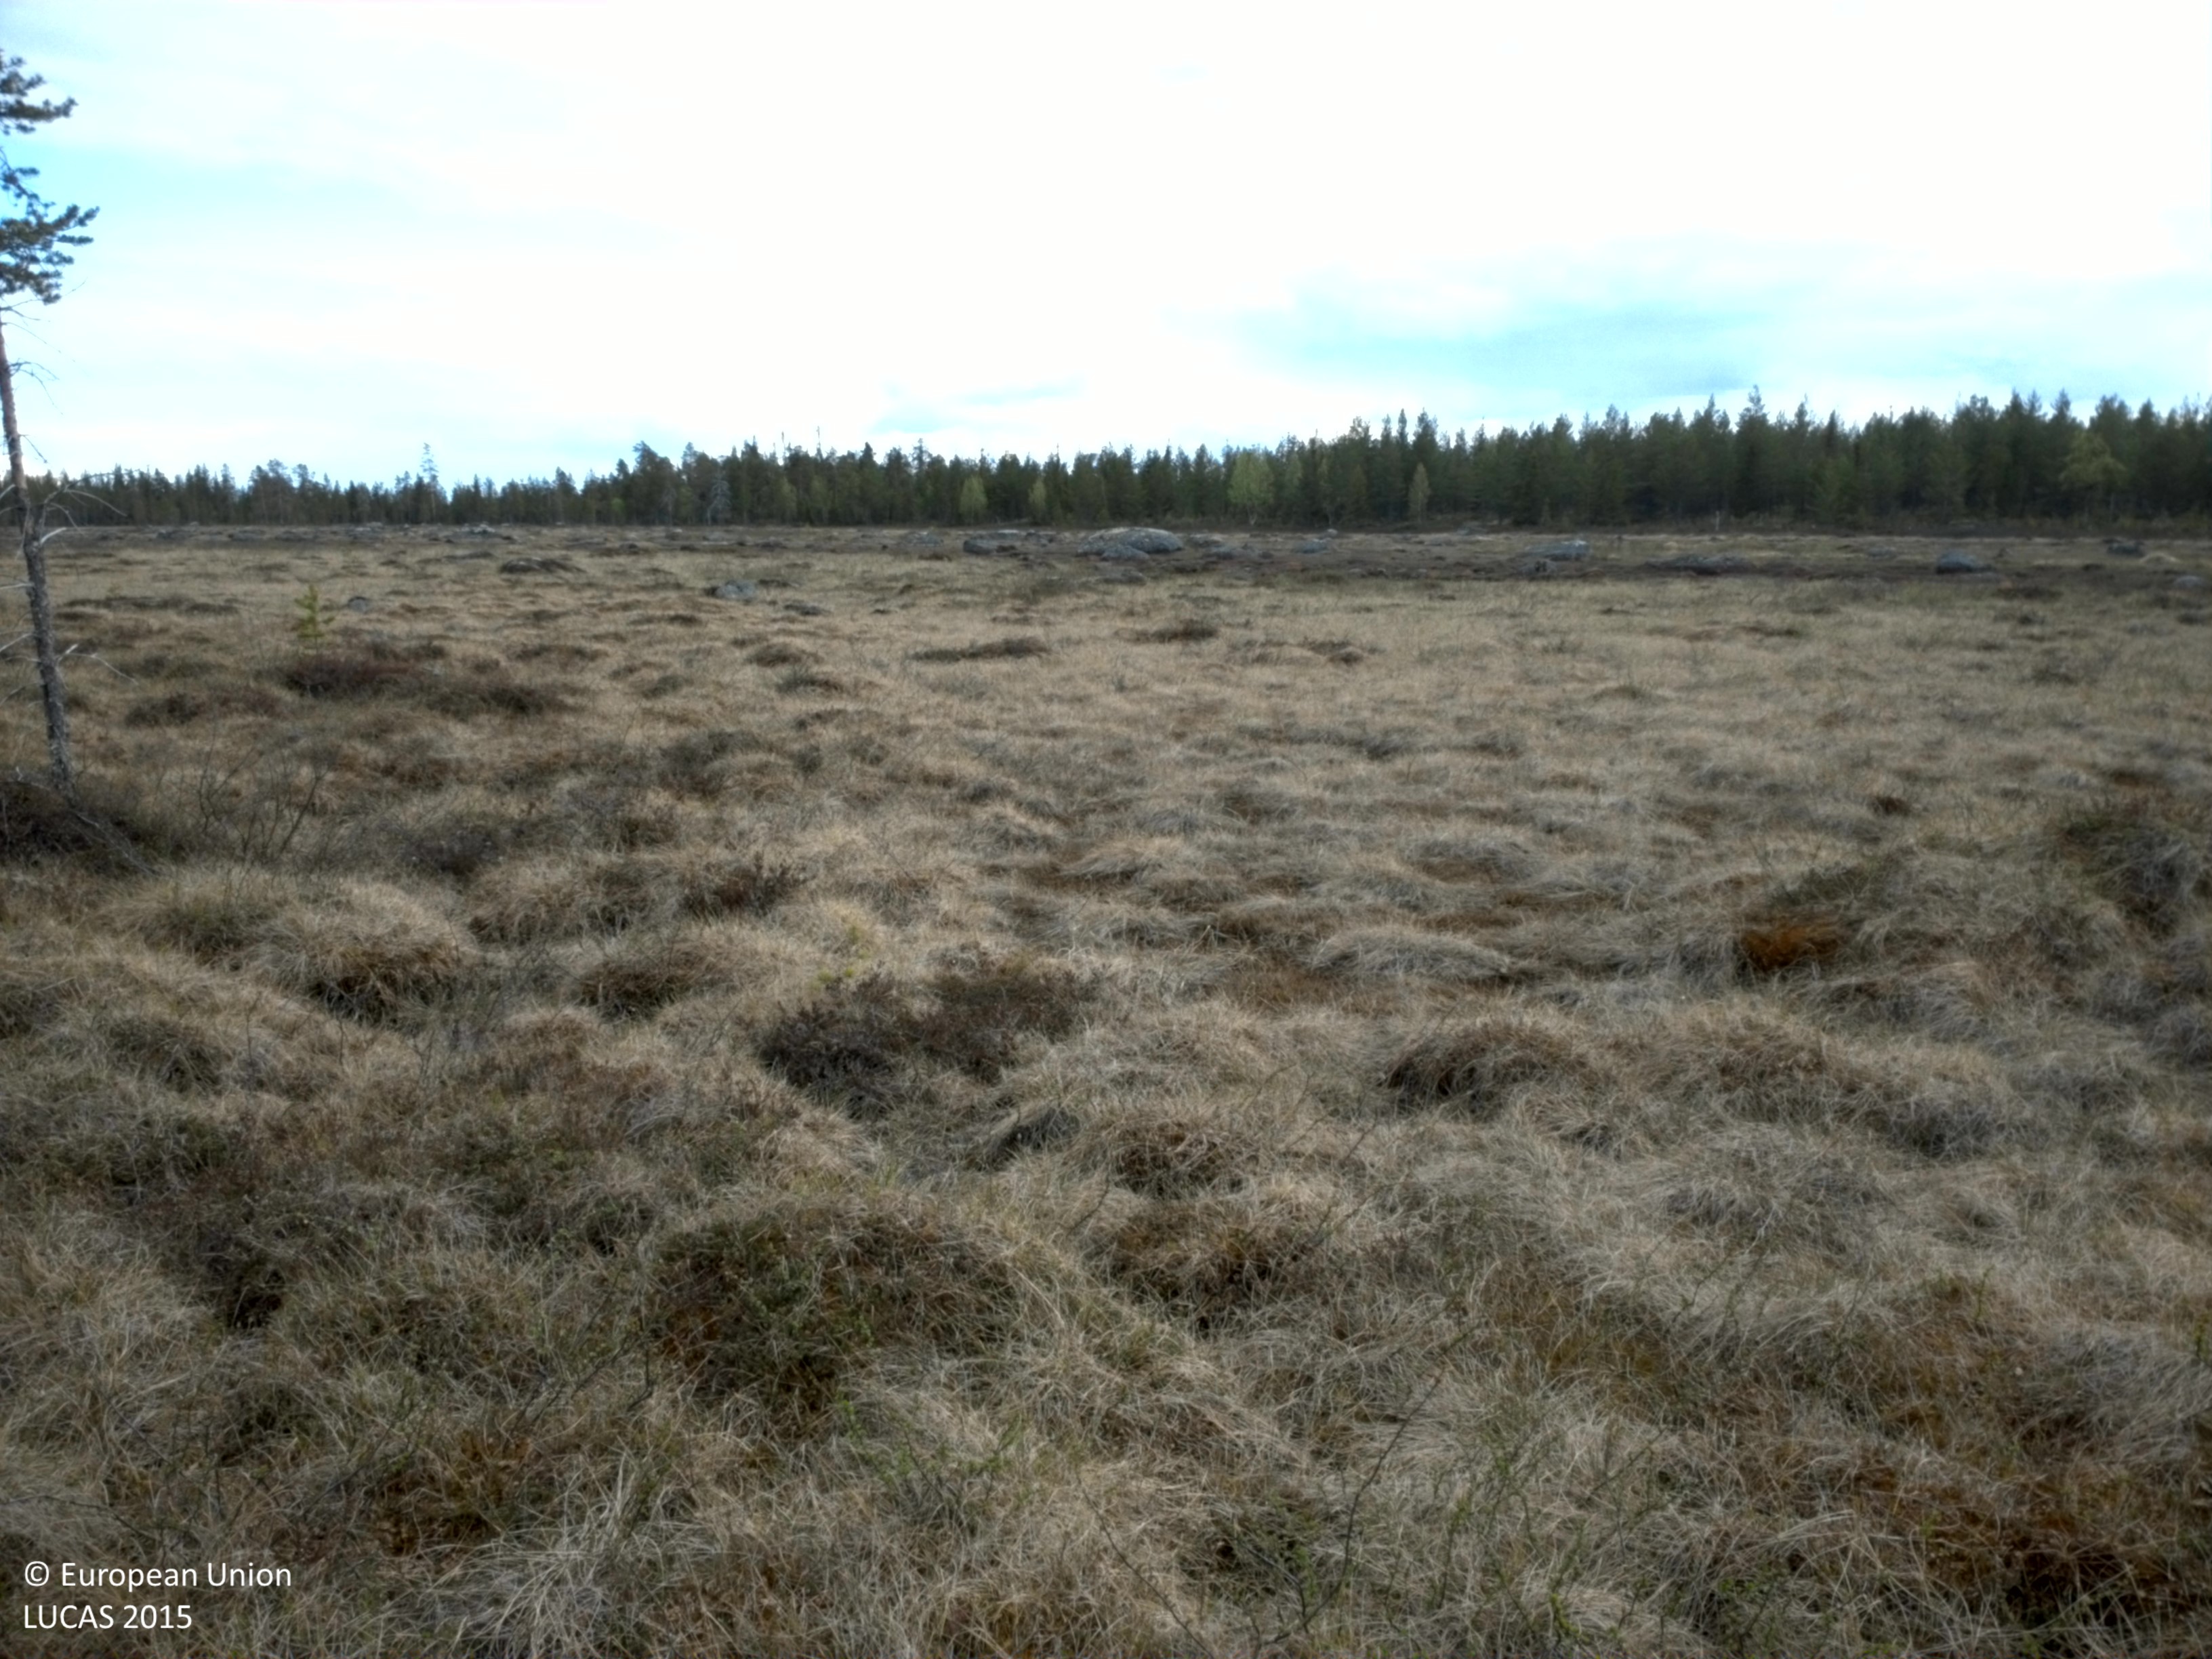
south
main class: Shrubland
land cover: Shrubland without tree cover
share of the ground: 25 - 50 %
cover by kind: herbaceous plants 60 %, shrubs 40 %
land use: Semi-natural and natural areas not in use
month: June
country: SE
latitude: 66.2526
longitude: 18.6992
